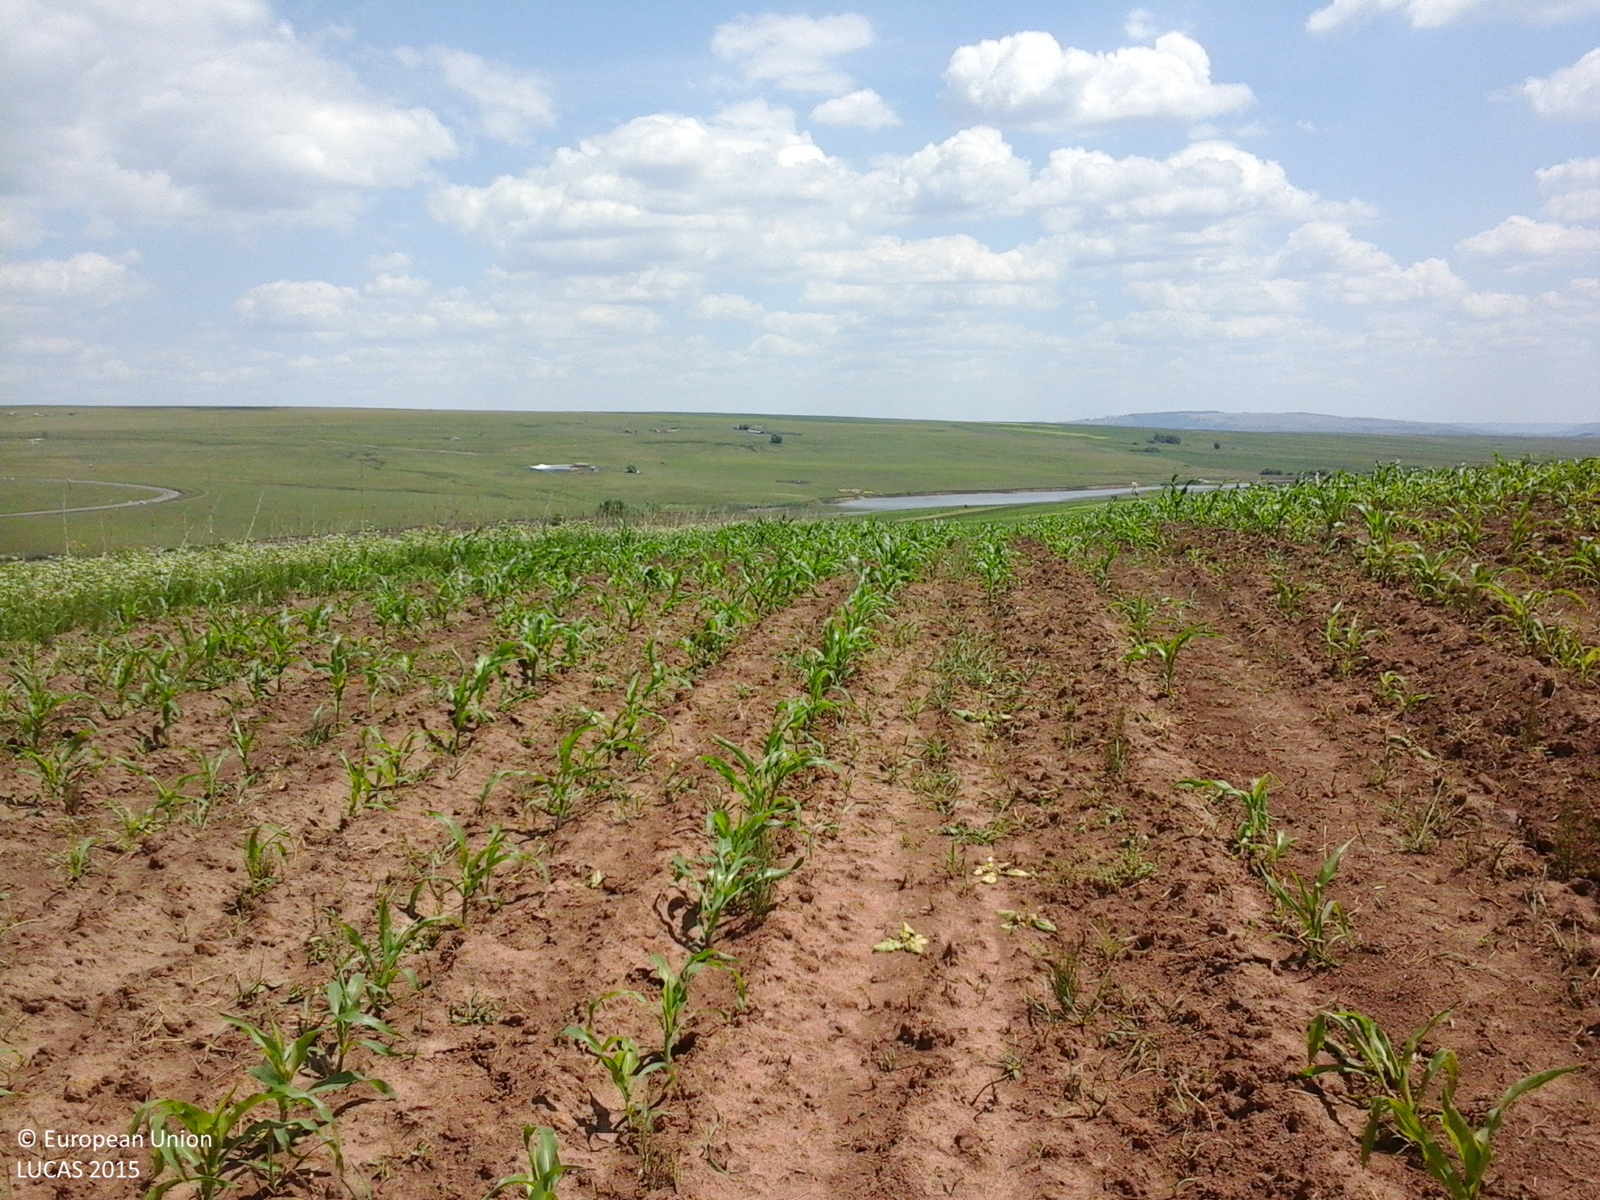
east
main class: Cropland
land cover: Maize
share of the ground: 10 - 25 %
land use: Agriculture (excluding fallow land and kitchen gardens)
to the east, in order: Maize; Spontaneously vegetated surfaces; Tracks; Sunflower; Spontaneously vegetated surfaces; Maize
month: June
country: RO
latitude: 47.5529
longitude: 26.2820
